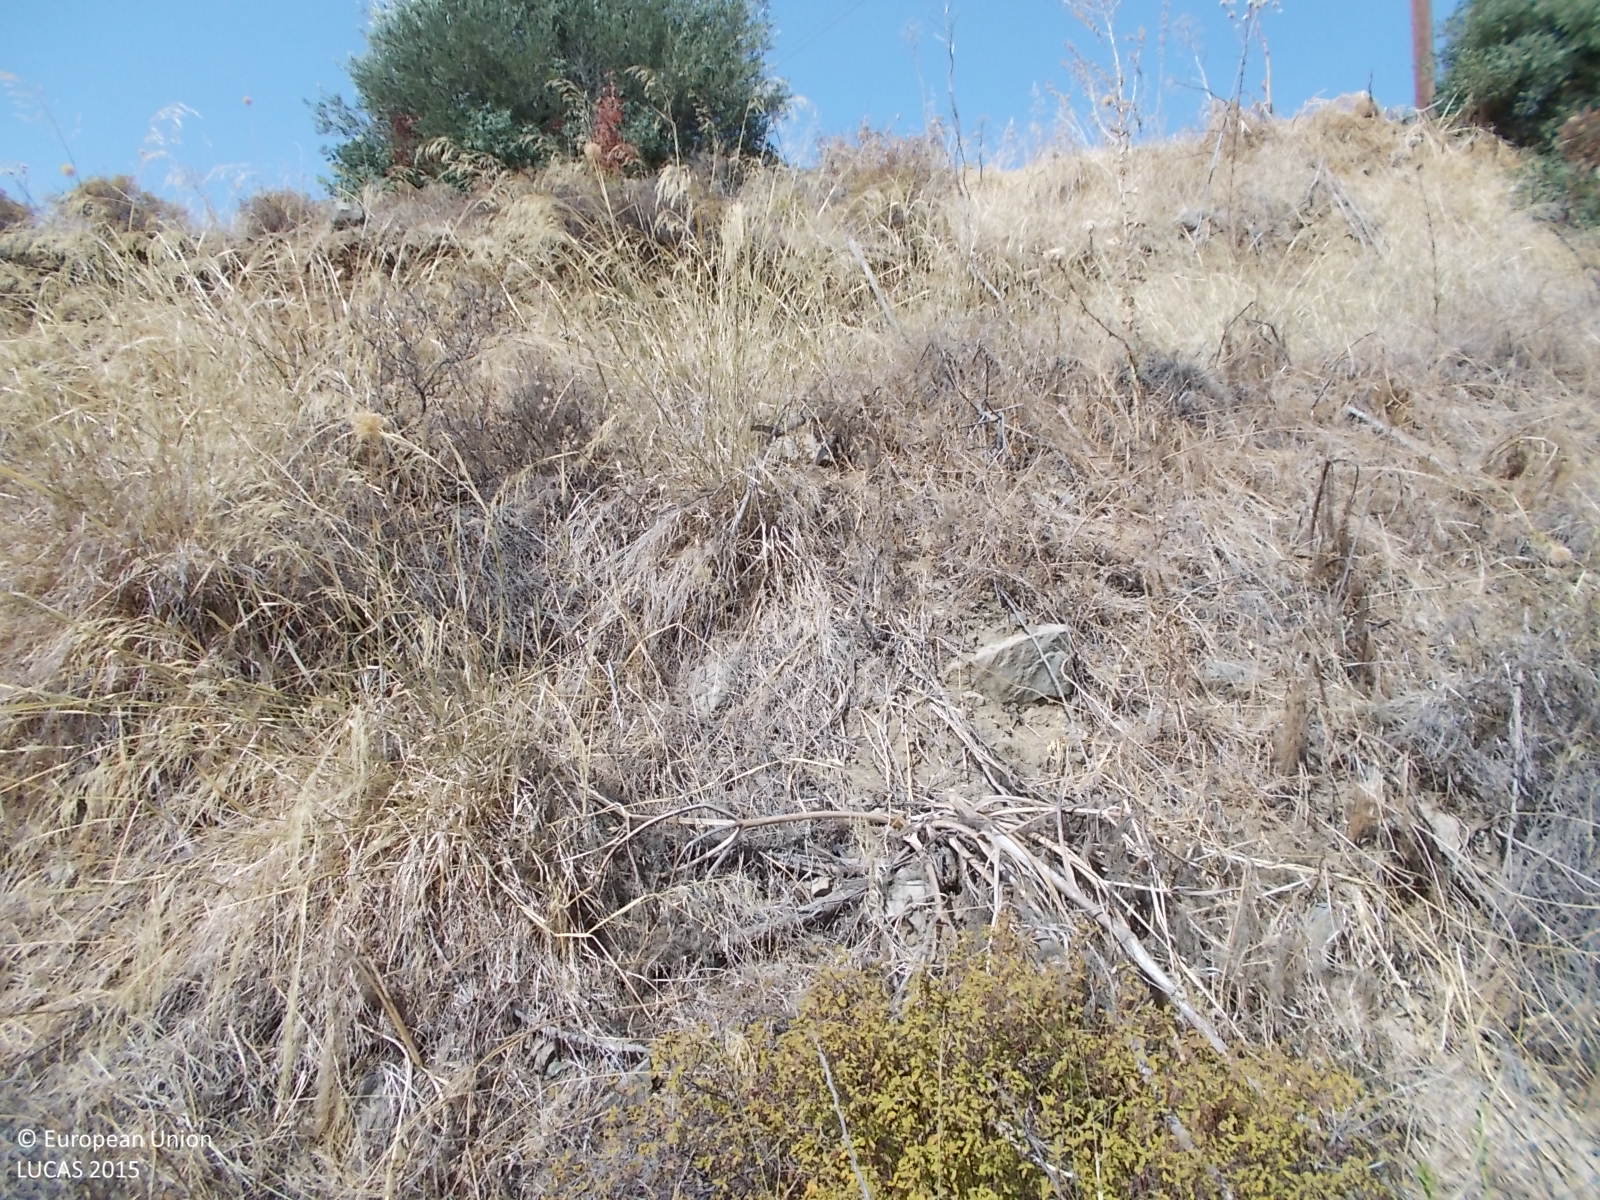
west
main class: Cropland
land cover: Nuts trees
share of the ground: 25 - 50 %
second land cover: Spontaneously vegetated surfaces
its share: > 75 %
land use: Abandoned areas
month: April
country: CY
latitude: 34.8659
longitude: 33.1583
